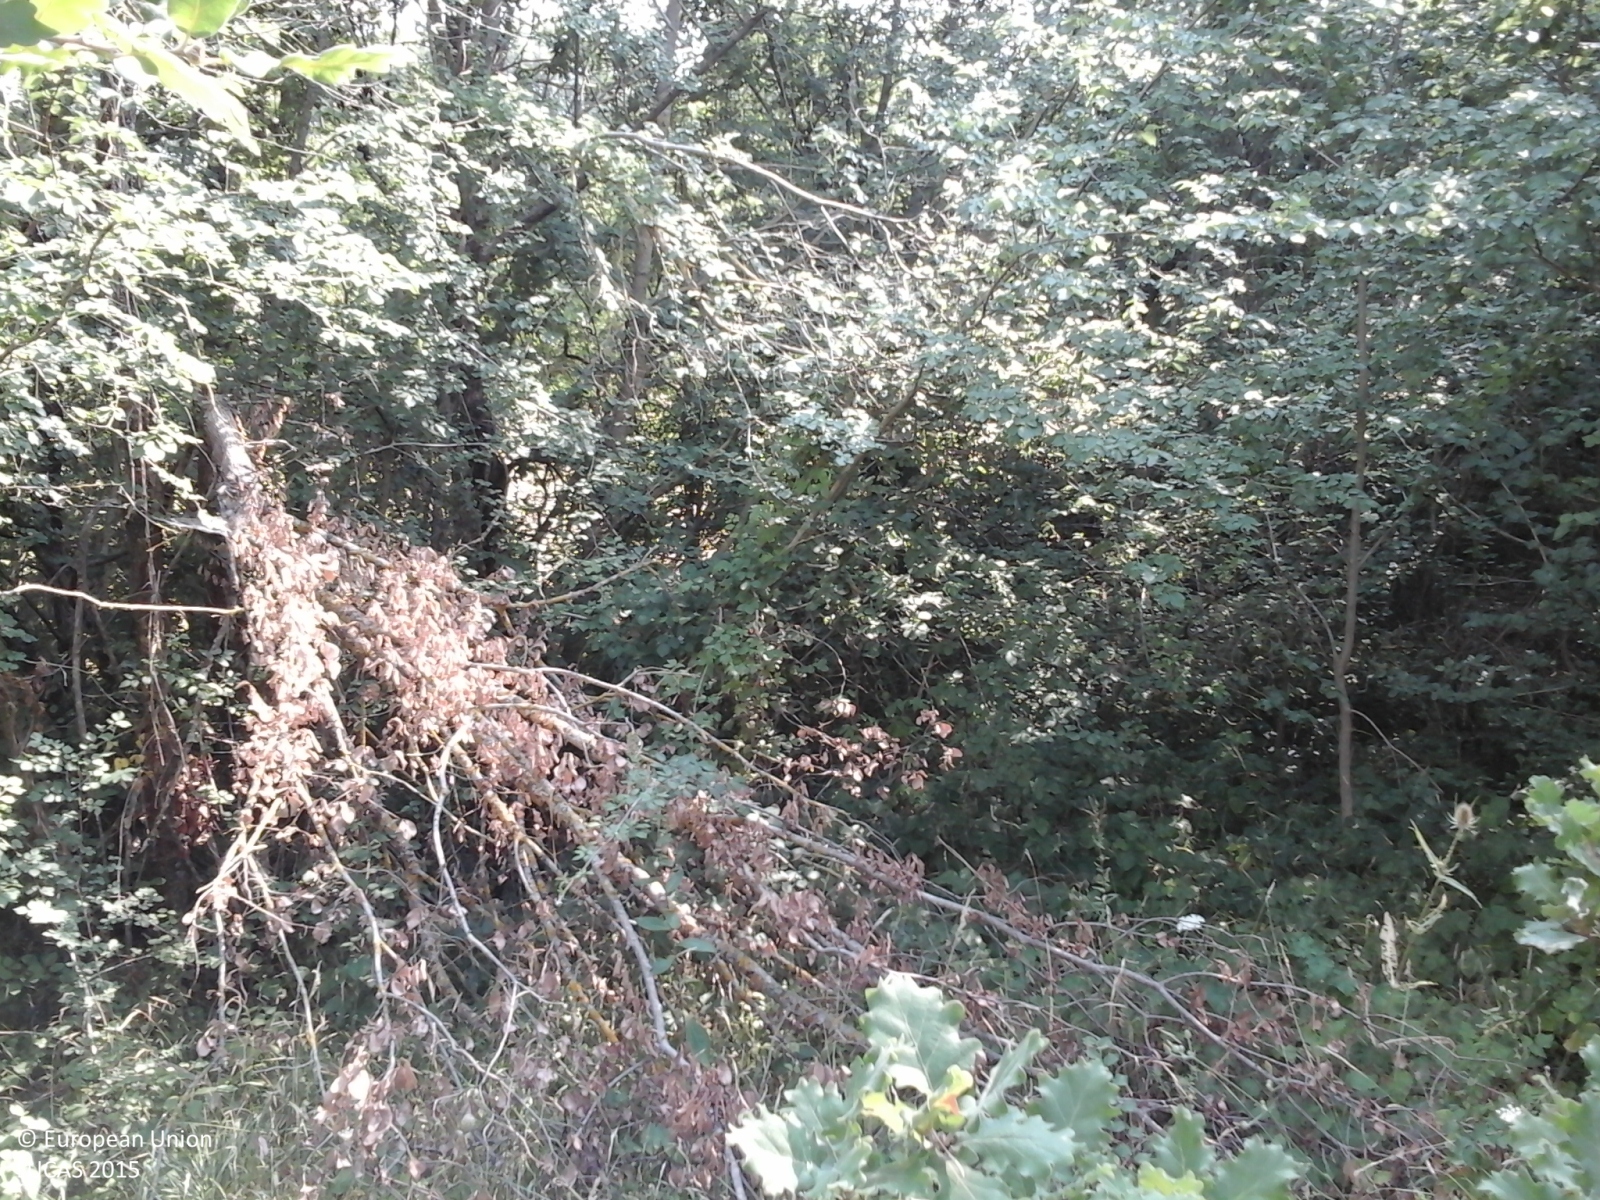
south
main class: Woodland
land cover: Broadleaved woodland
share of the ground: > 75 %
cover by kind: herbaceous plants 65 %, broadleaved forest trees 25 %, shrubs 10 %
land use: Semi-natural and natural areas not in use
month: August
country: IT
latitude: 41.5778
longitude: 14.4819
